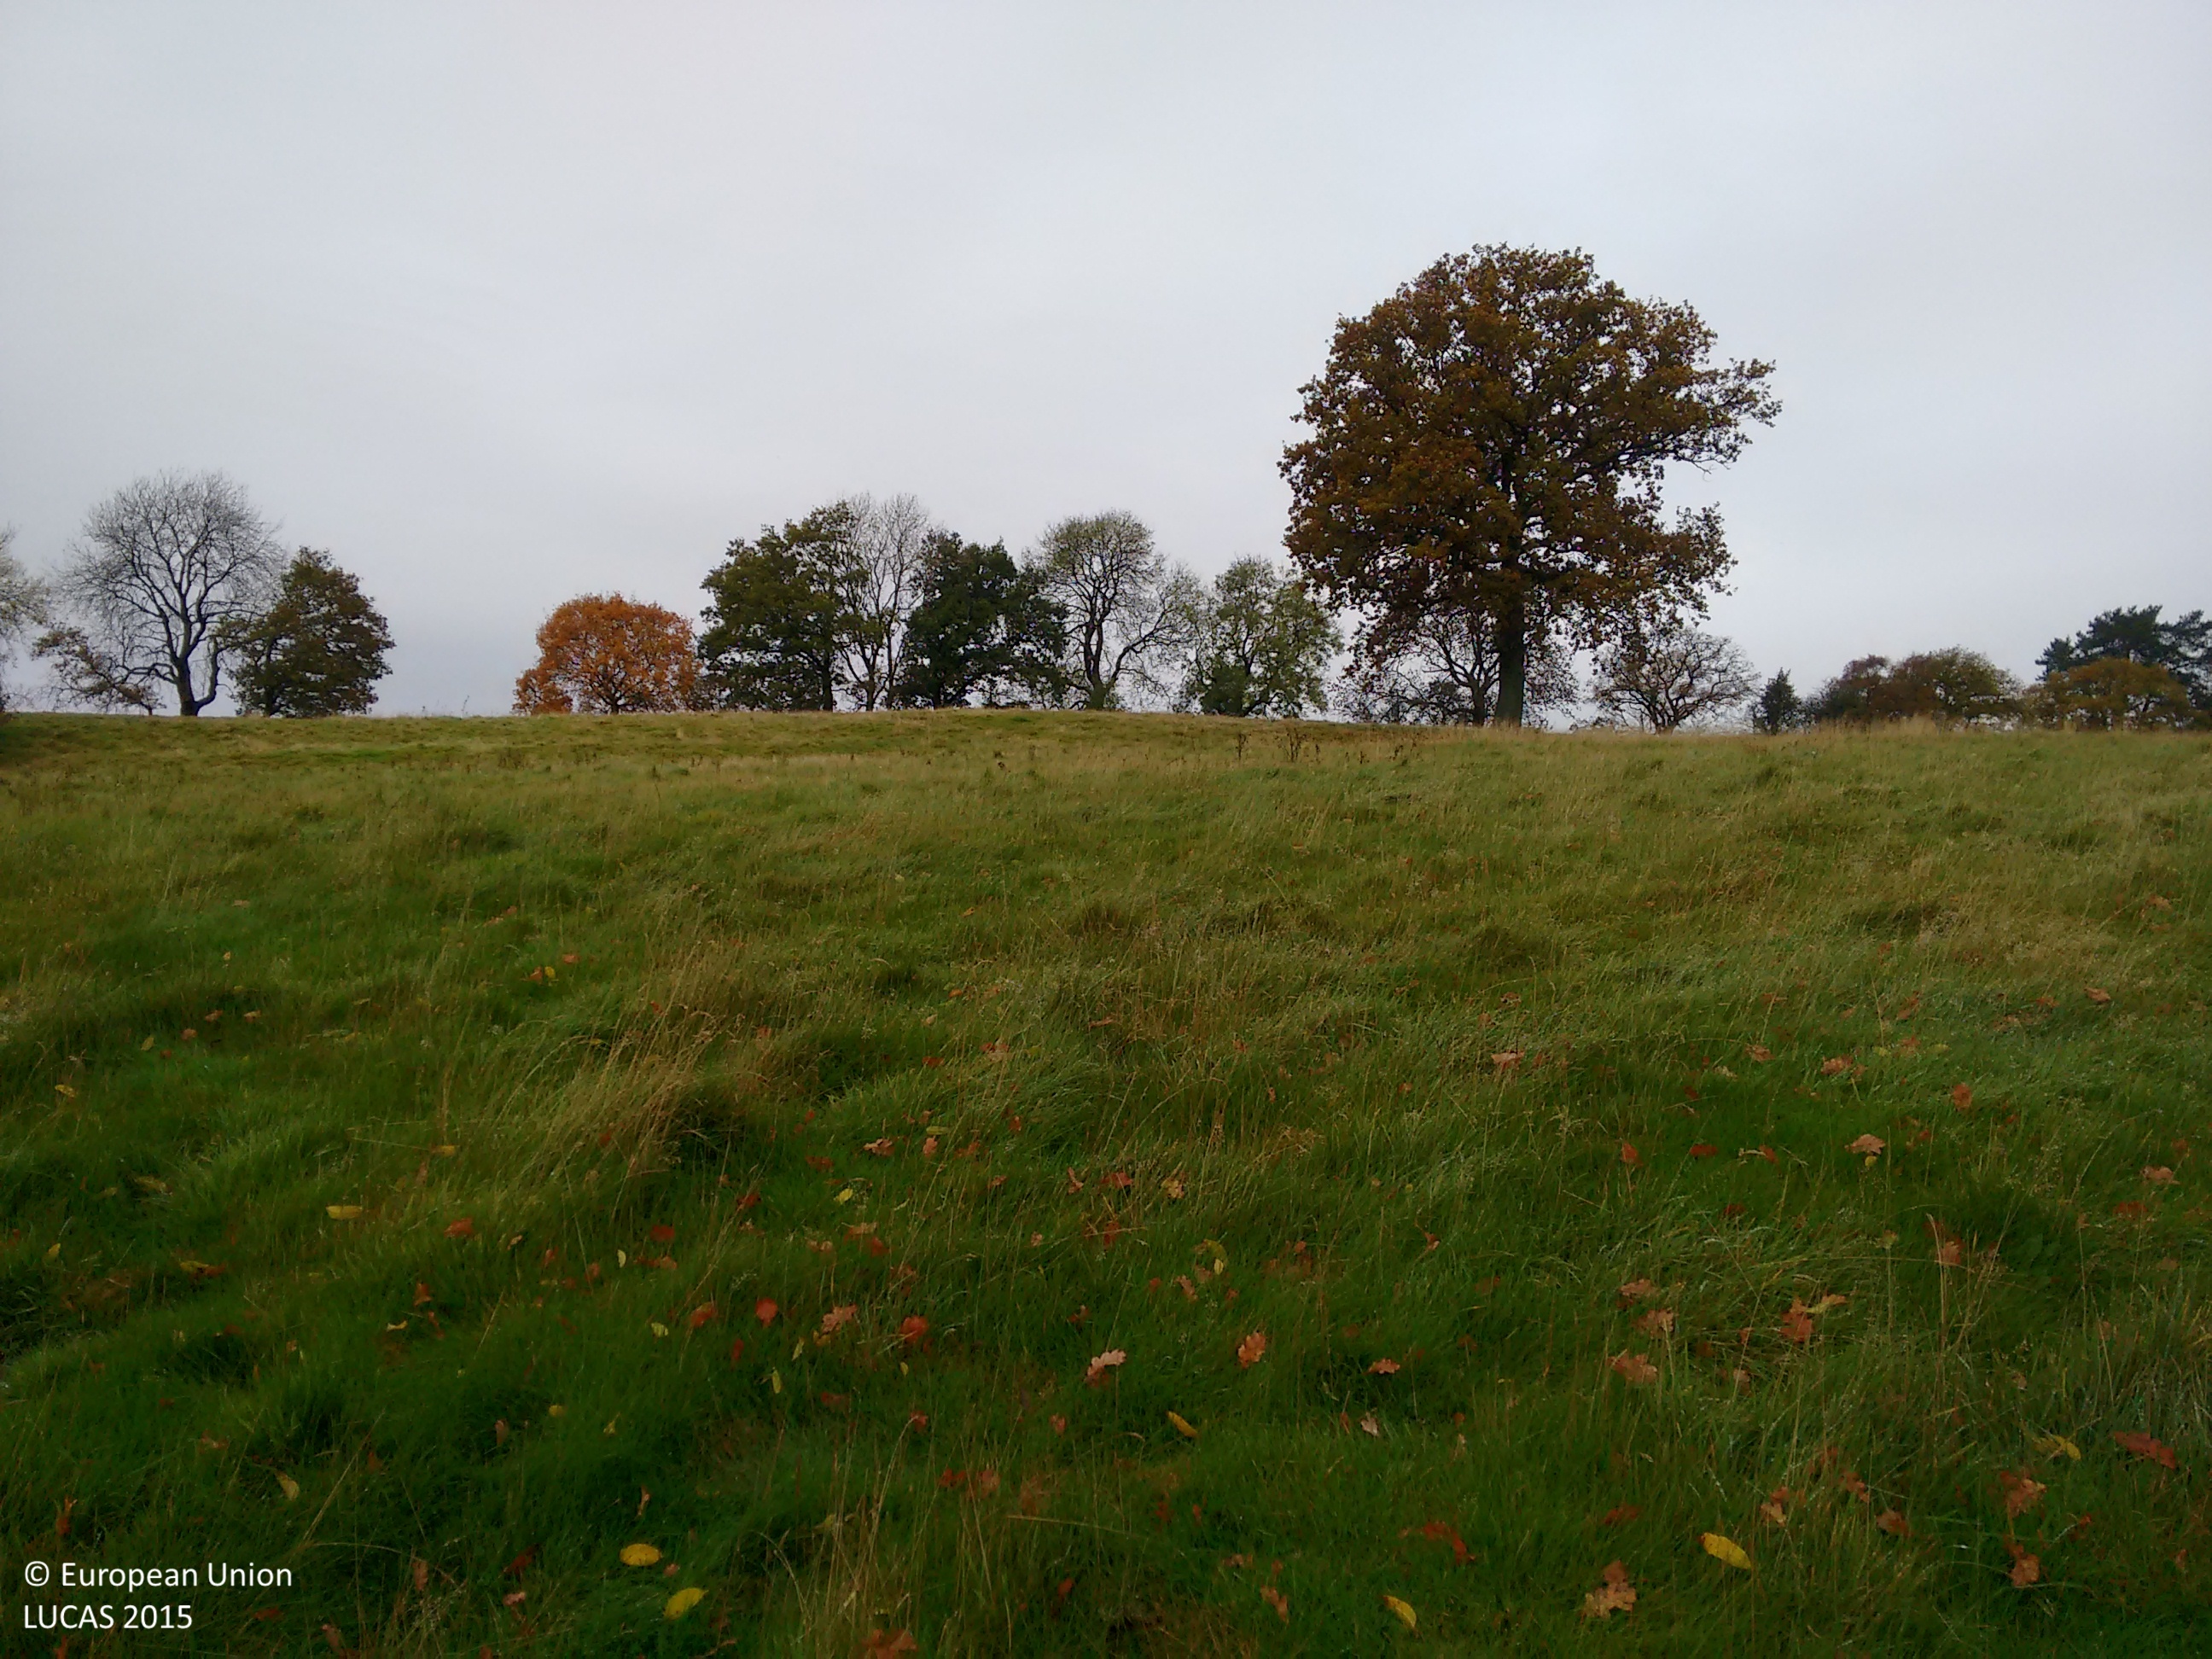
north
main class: Grassland
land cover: Grassland without tree/shrub cover
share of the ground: > 75 %
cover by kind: herbaceous plants 100 %
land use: Agriculture (excluding fallow land and kitchen gardens)
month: October
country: GB
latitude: 52.3734
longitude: -2.6272
